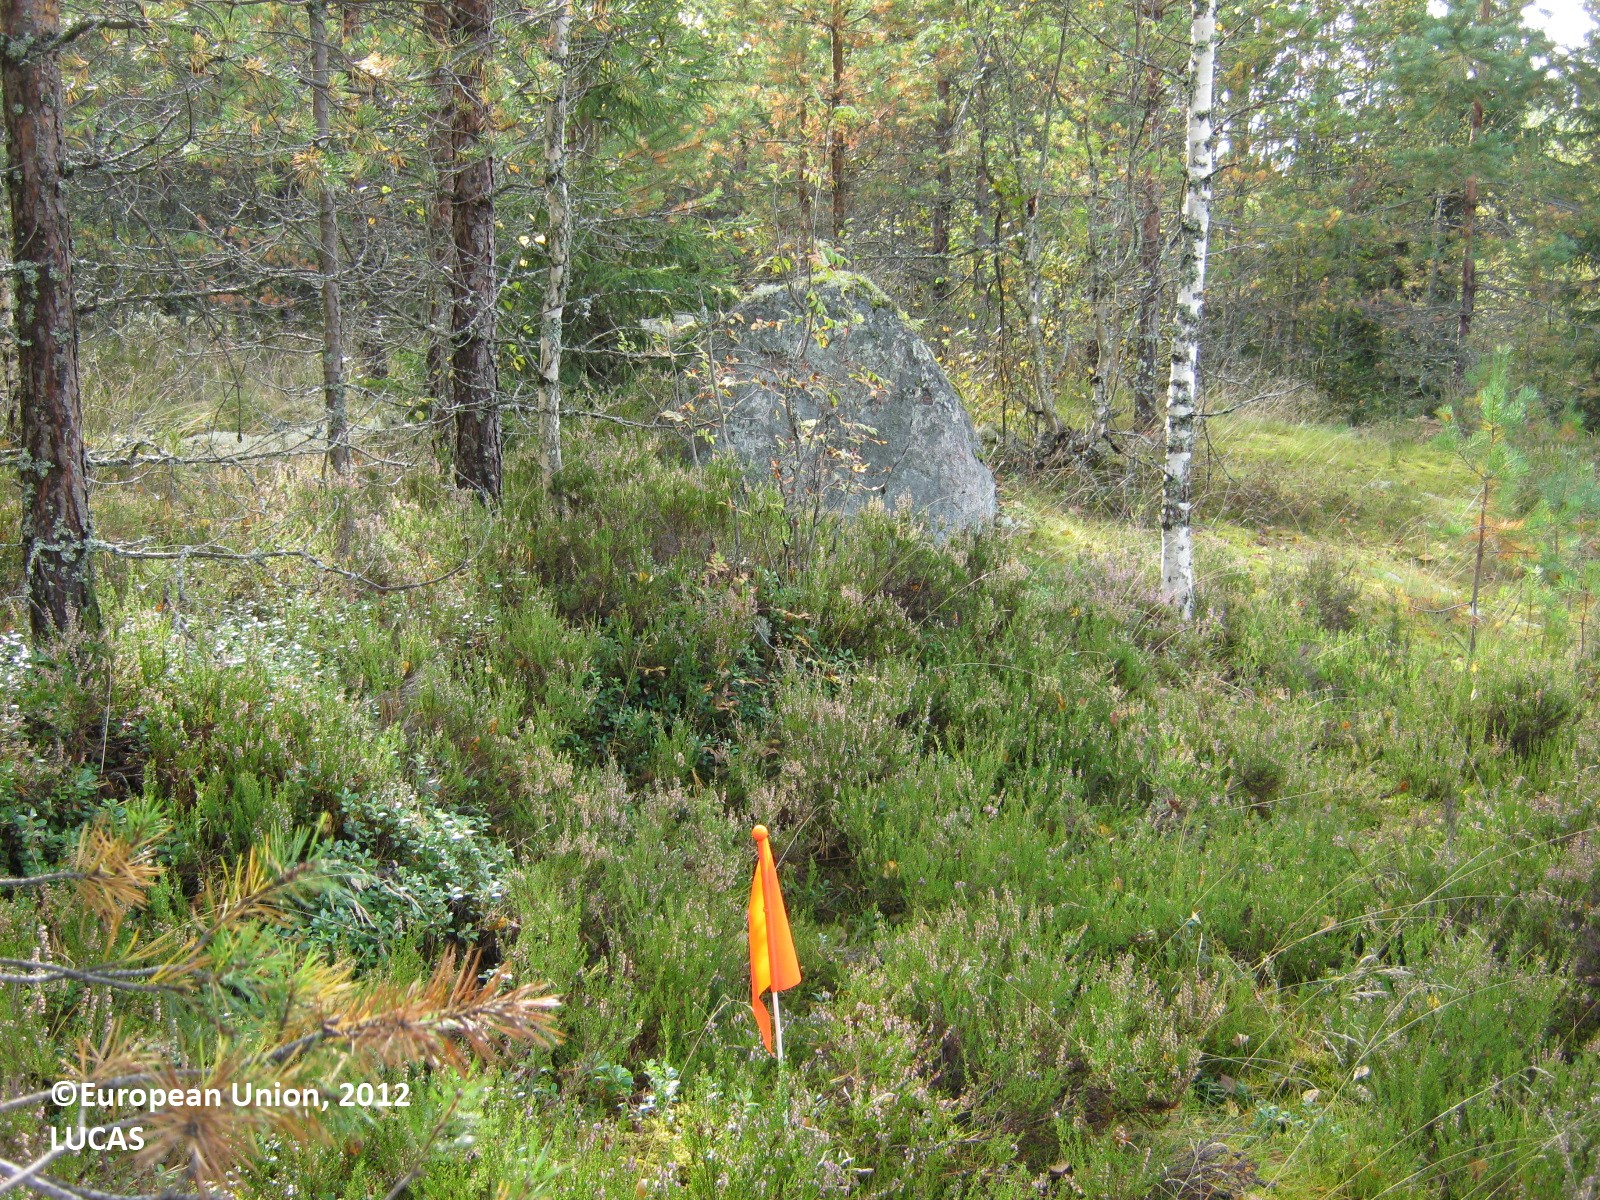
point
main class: Woodland
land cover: Pine dominated mixed woodland
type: boreal forest
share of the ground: > 75 %
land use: Forestry
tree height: > 5 m
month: September
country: FI
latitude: 60.6191
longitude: 27.8674
